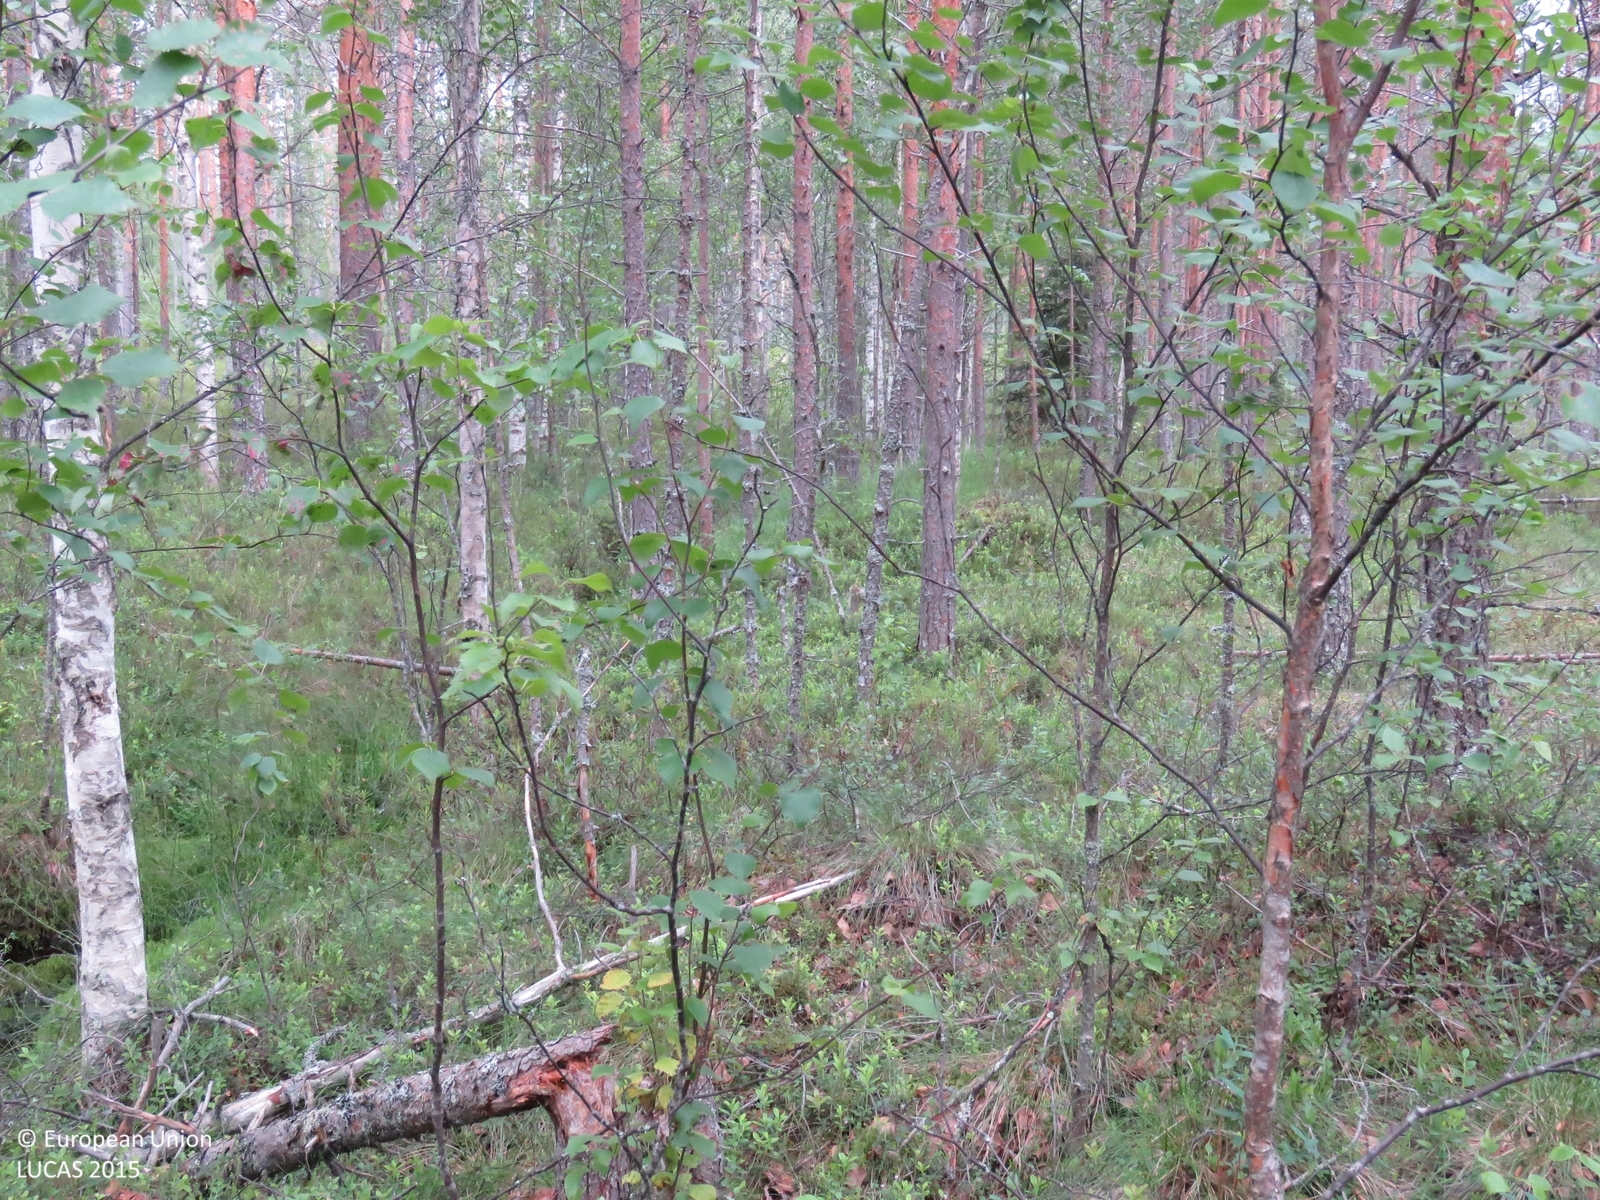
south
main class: Woodland
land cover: Pine dominated coniferous woodland
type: mire and swamp forests
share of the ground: > 75 %
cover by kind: coniferous forest trees 70 %, broadleaved forest trees 20 %, shrubs 10 %
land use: Forestry
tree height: > 5 m
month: July
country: FI
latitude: 64.2814
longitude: 26.5380
